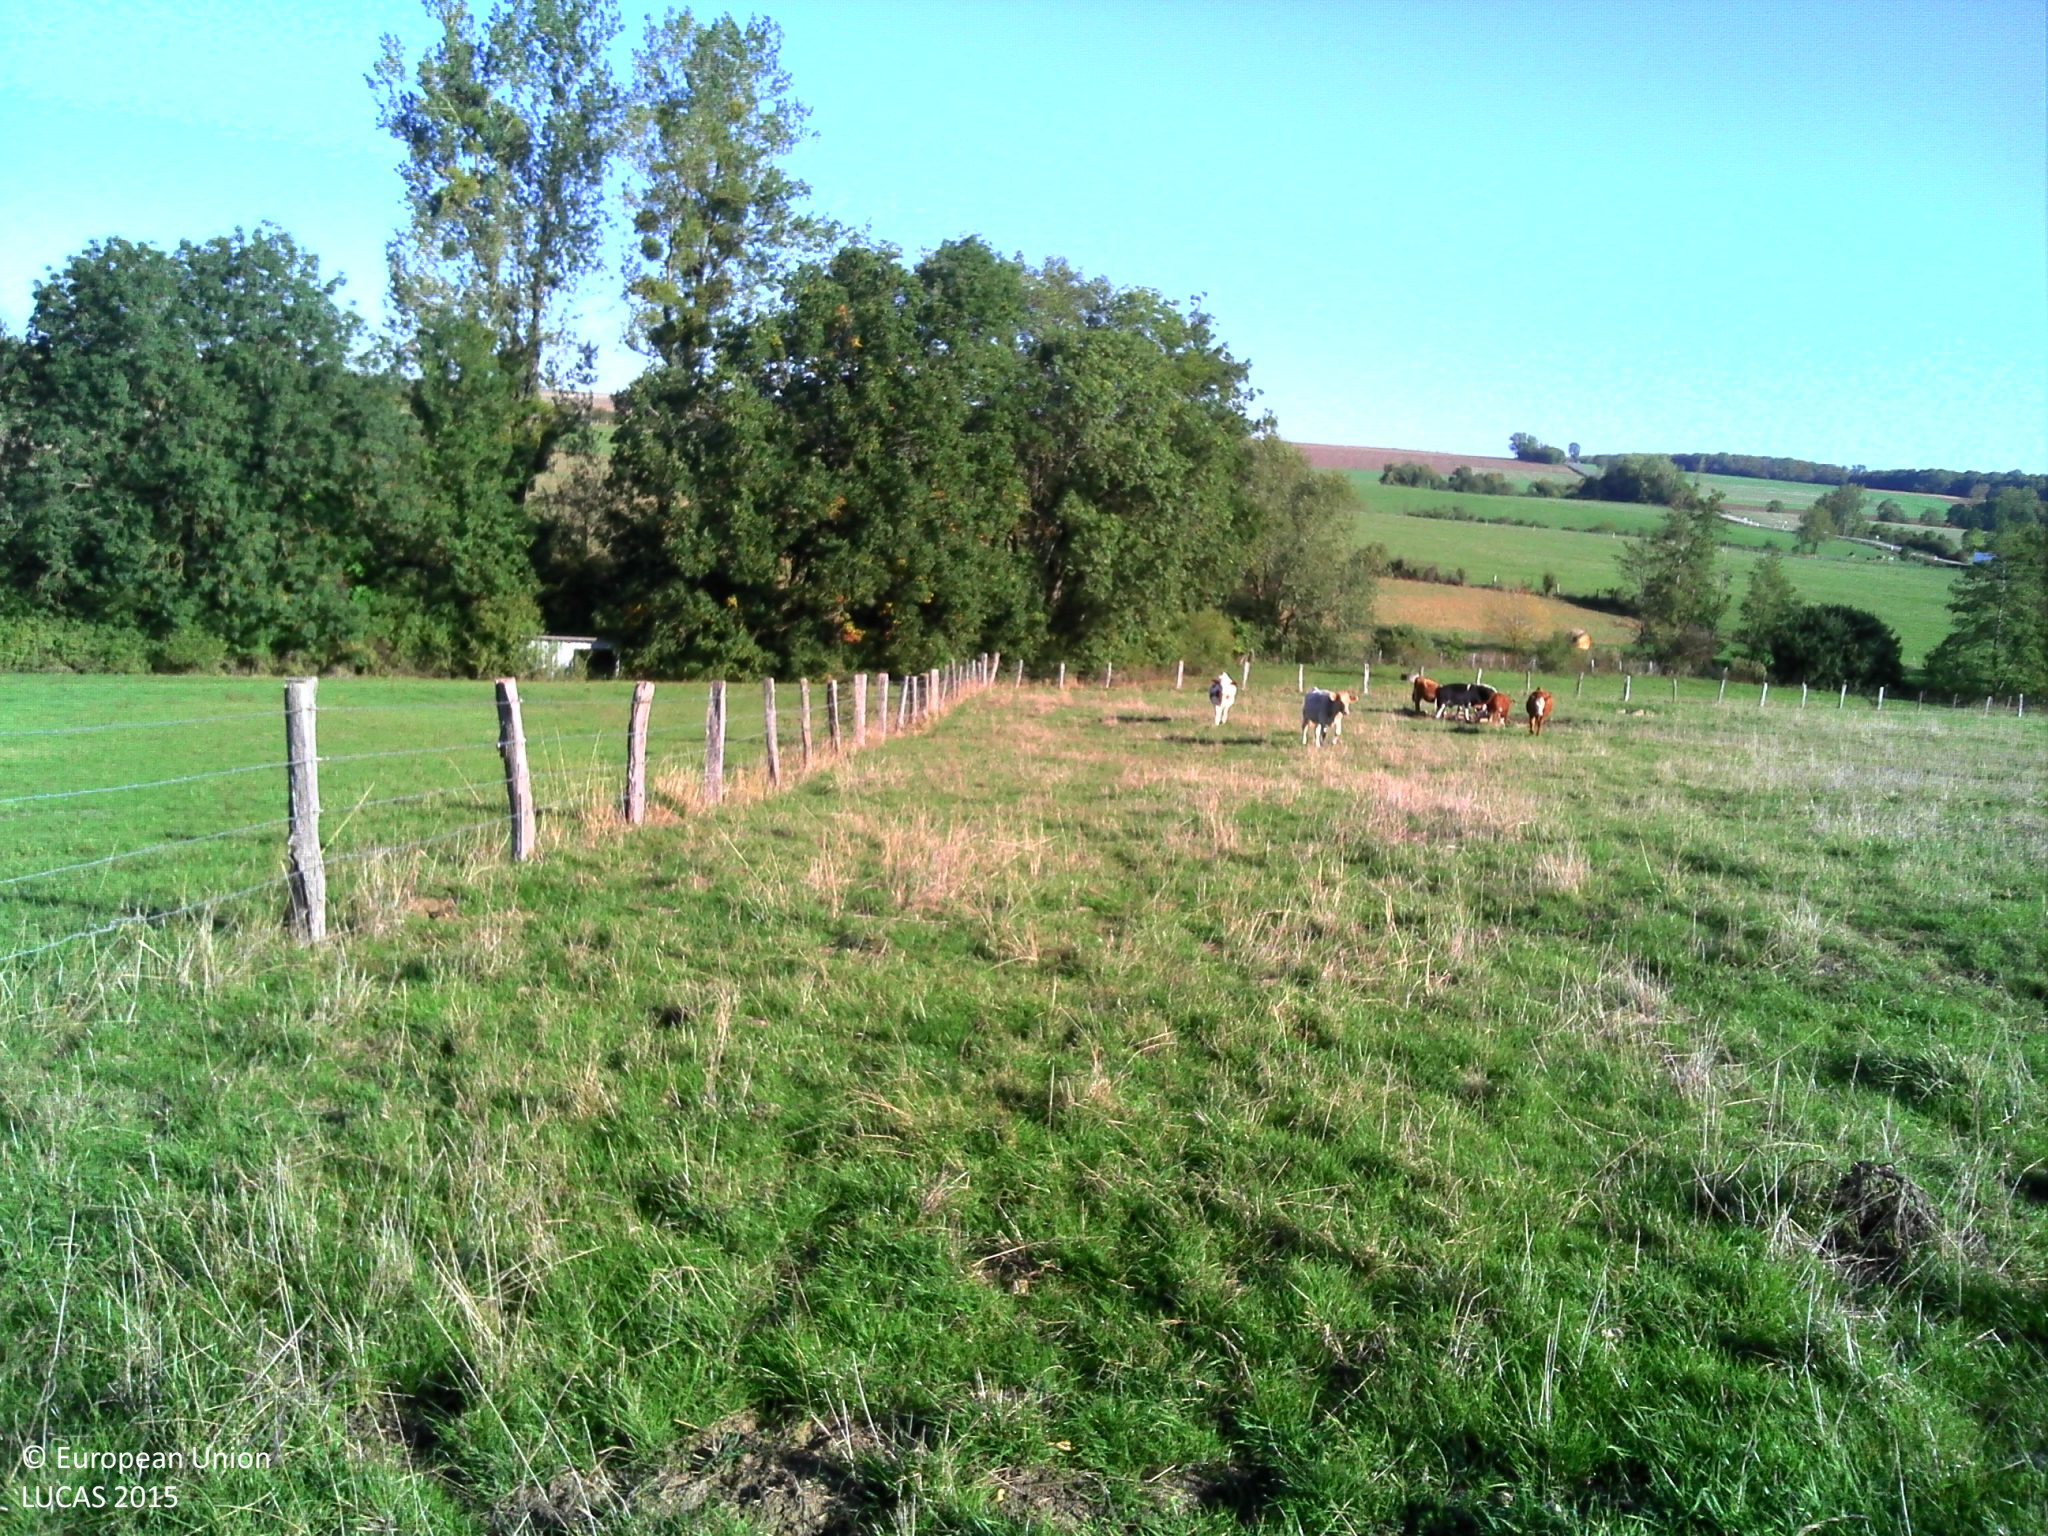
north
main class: Grassland
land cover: Grassland without tree/shrub cover
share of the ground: > 75 %
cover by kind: herbaceous plants 95 %, consolidated bare surface 5 %
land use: Agriculture (excluding fallow land and kitchen gardens)
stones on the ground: < 10 %
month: September
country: FR
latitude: 48.4256
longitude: 6.1217
